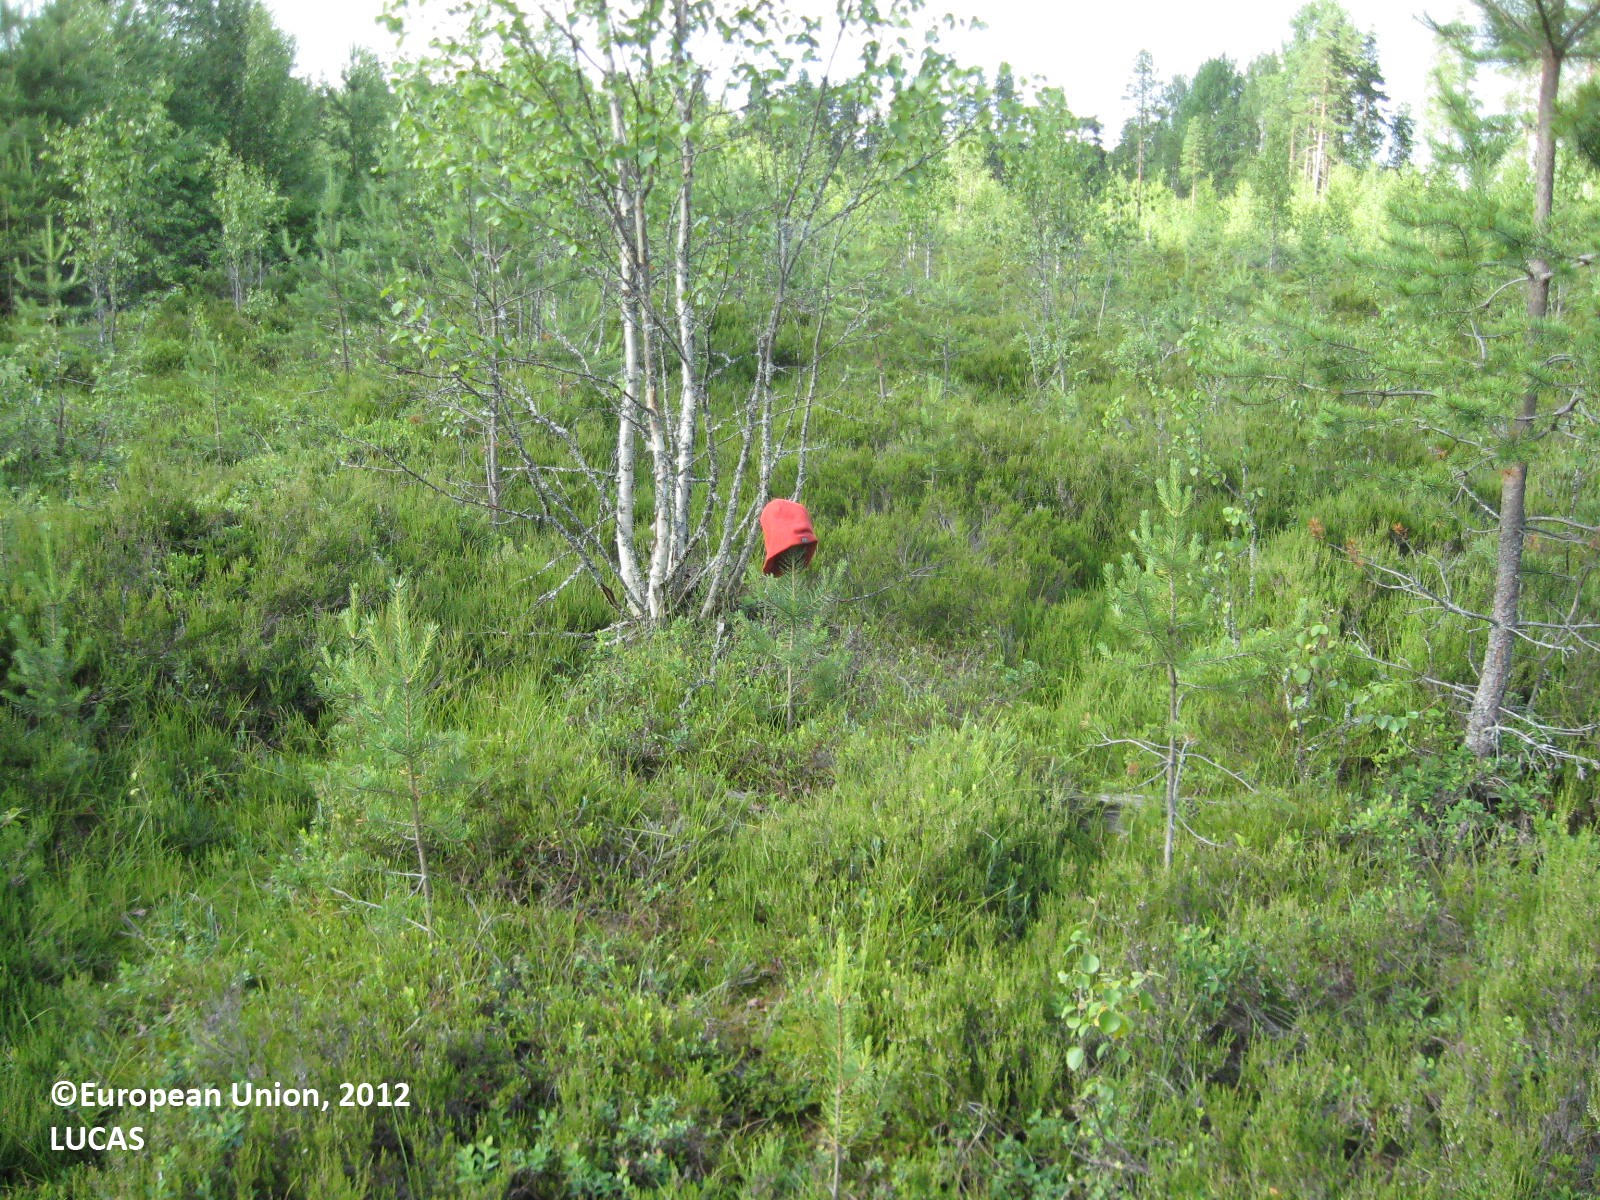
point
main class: Woodland
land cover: Other mixed woodland
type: boreal forest
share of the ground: 25 - 50 %
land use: Forestry
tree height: < 5 m
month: July
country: FI
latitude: 62.2750
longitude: 22.6804
